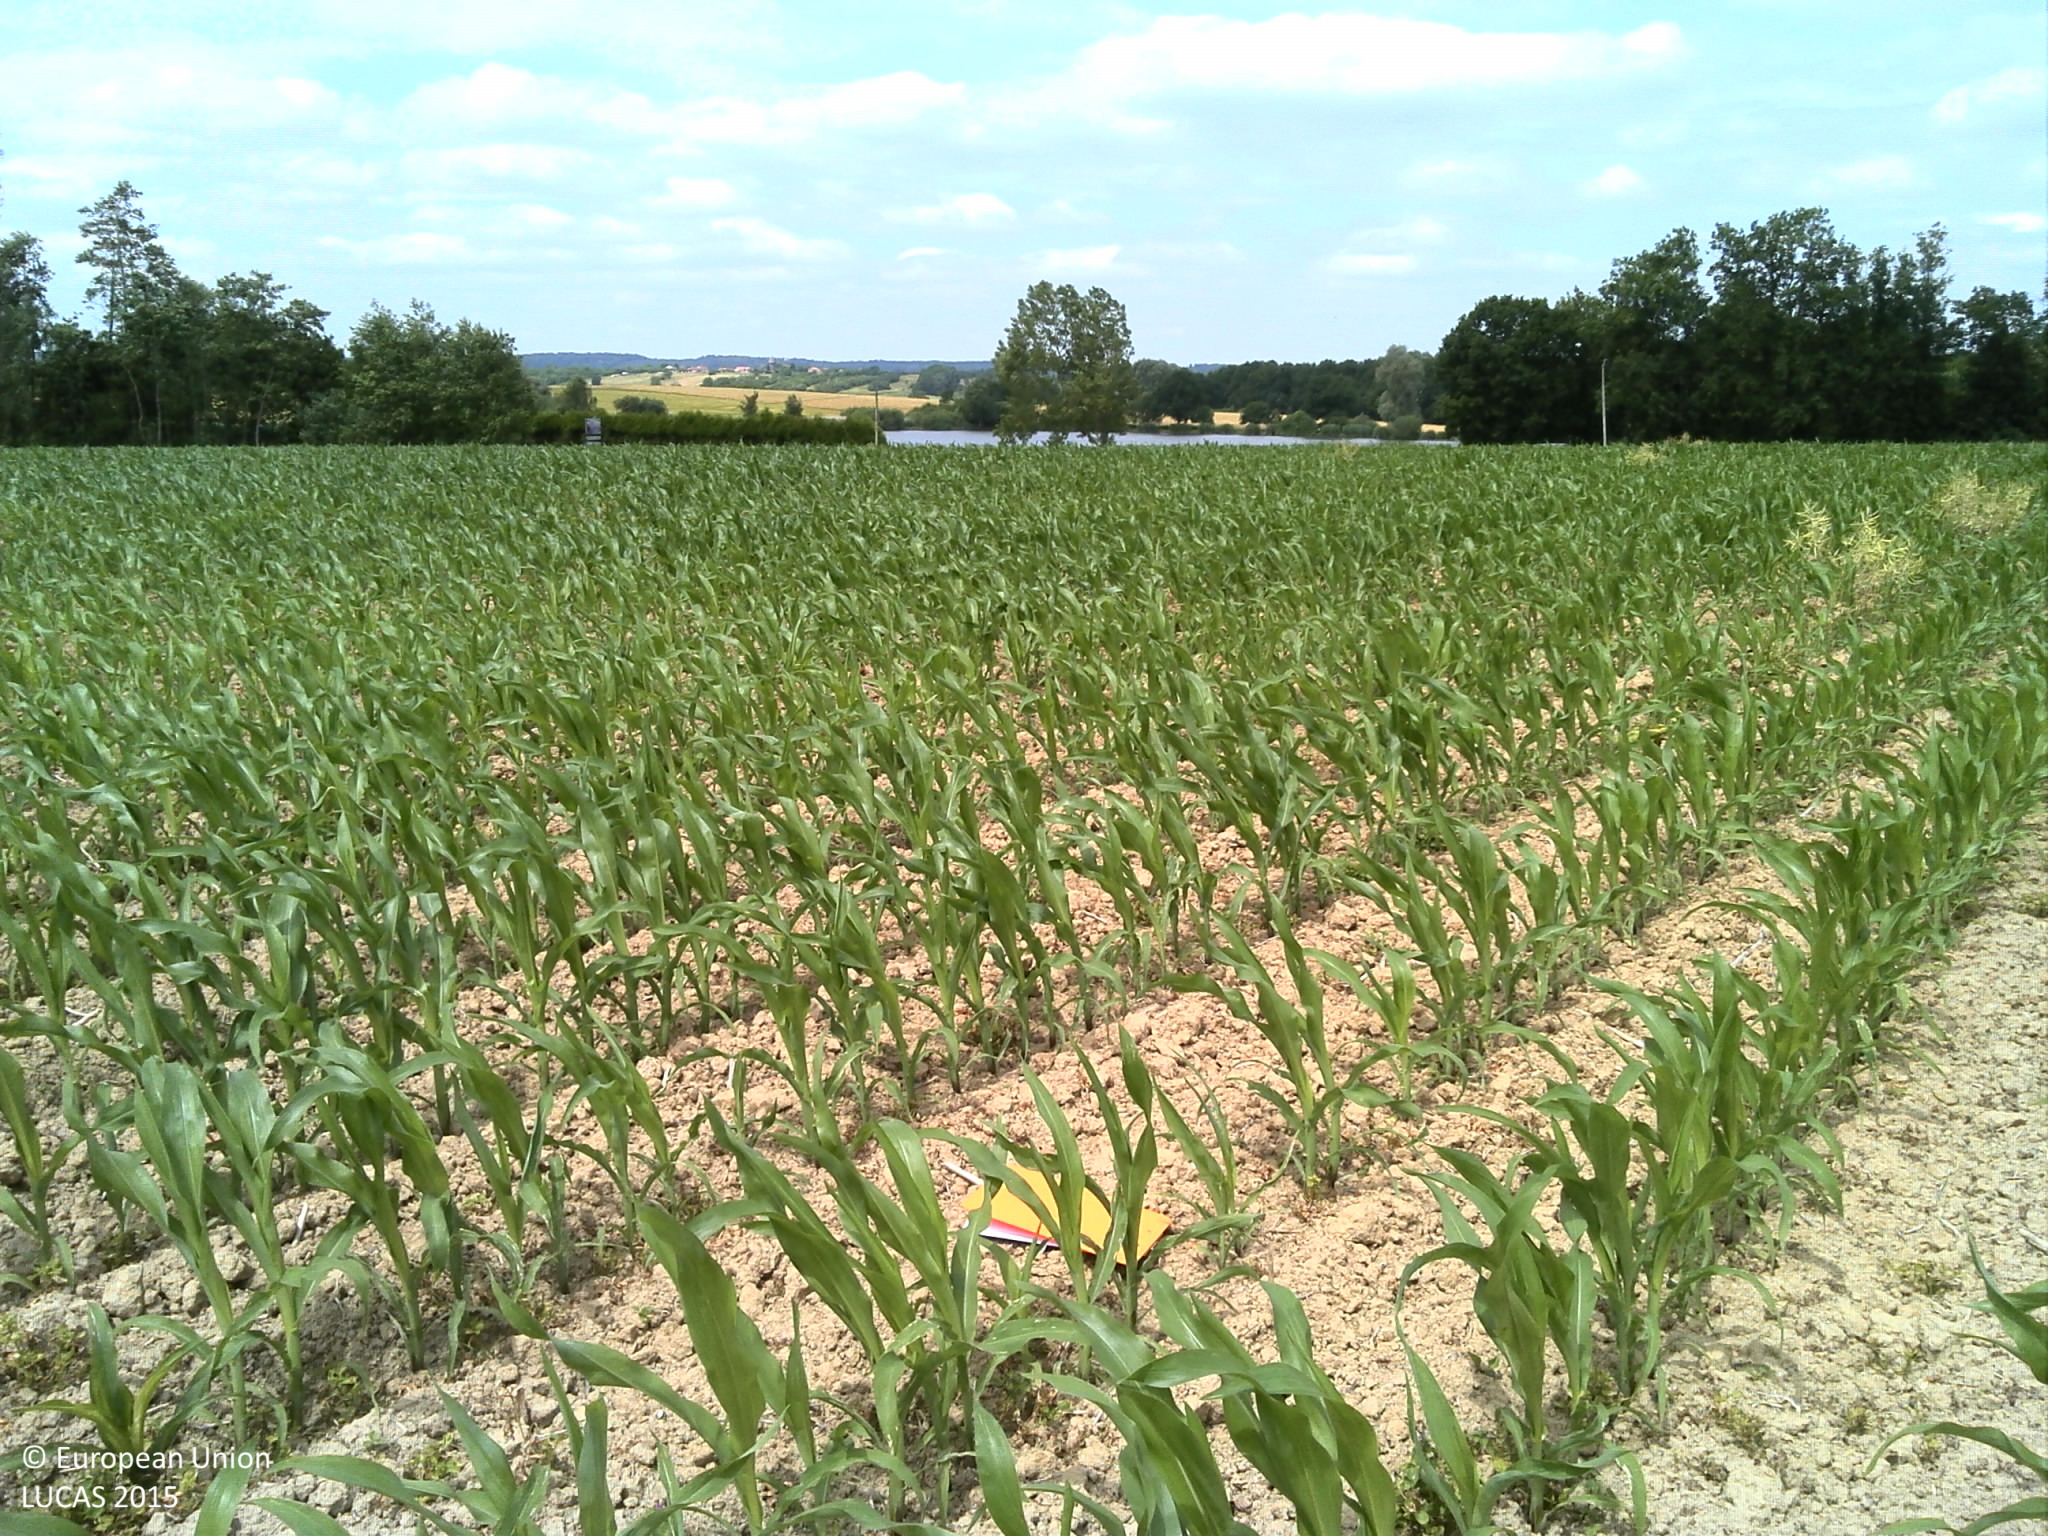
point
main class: Cropland
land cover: Maize
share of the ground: 50 - 75 %
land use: Agriculture (excluding fallow land and kitchen gardens)
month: June
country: FR
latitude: 48.8246
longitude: 6.7722
